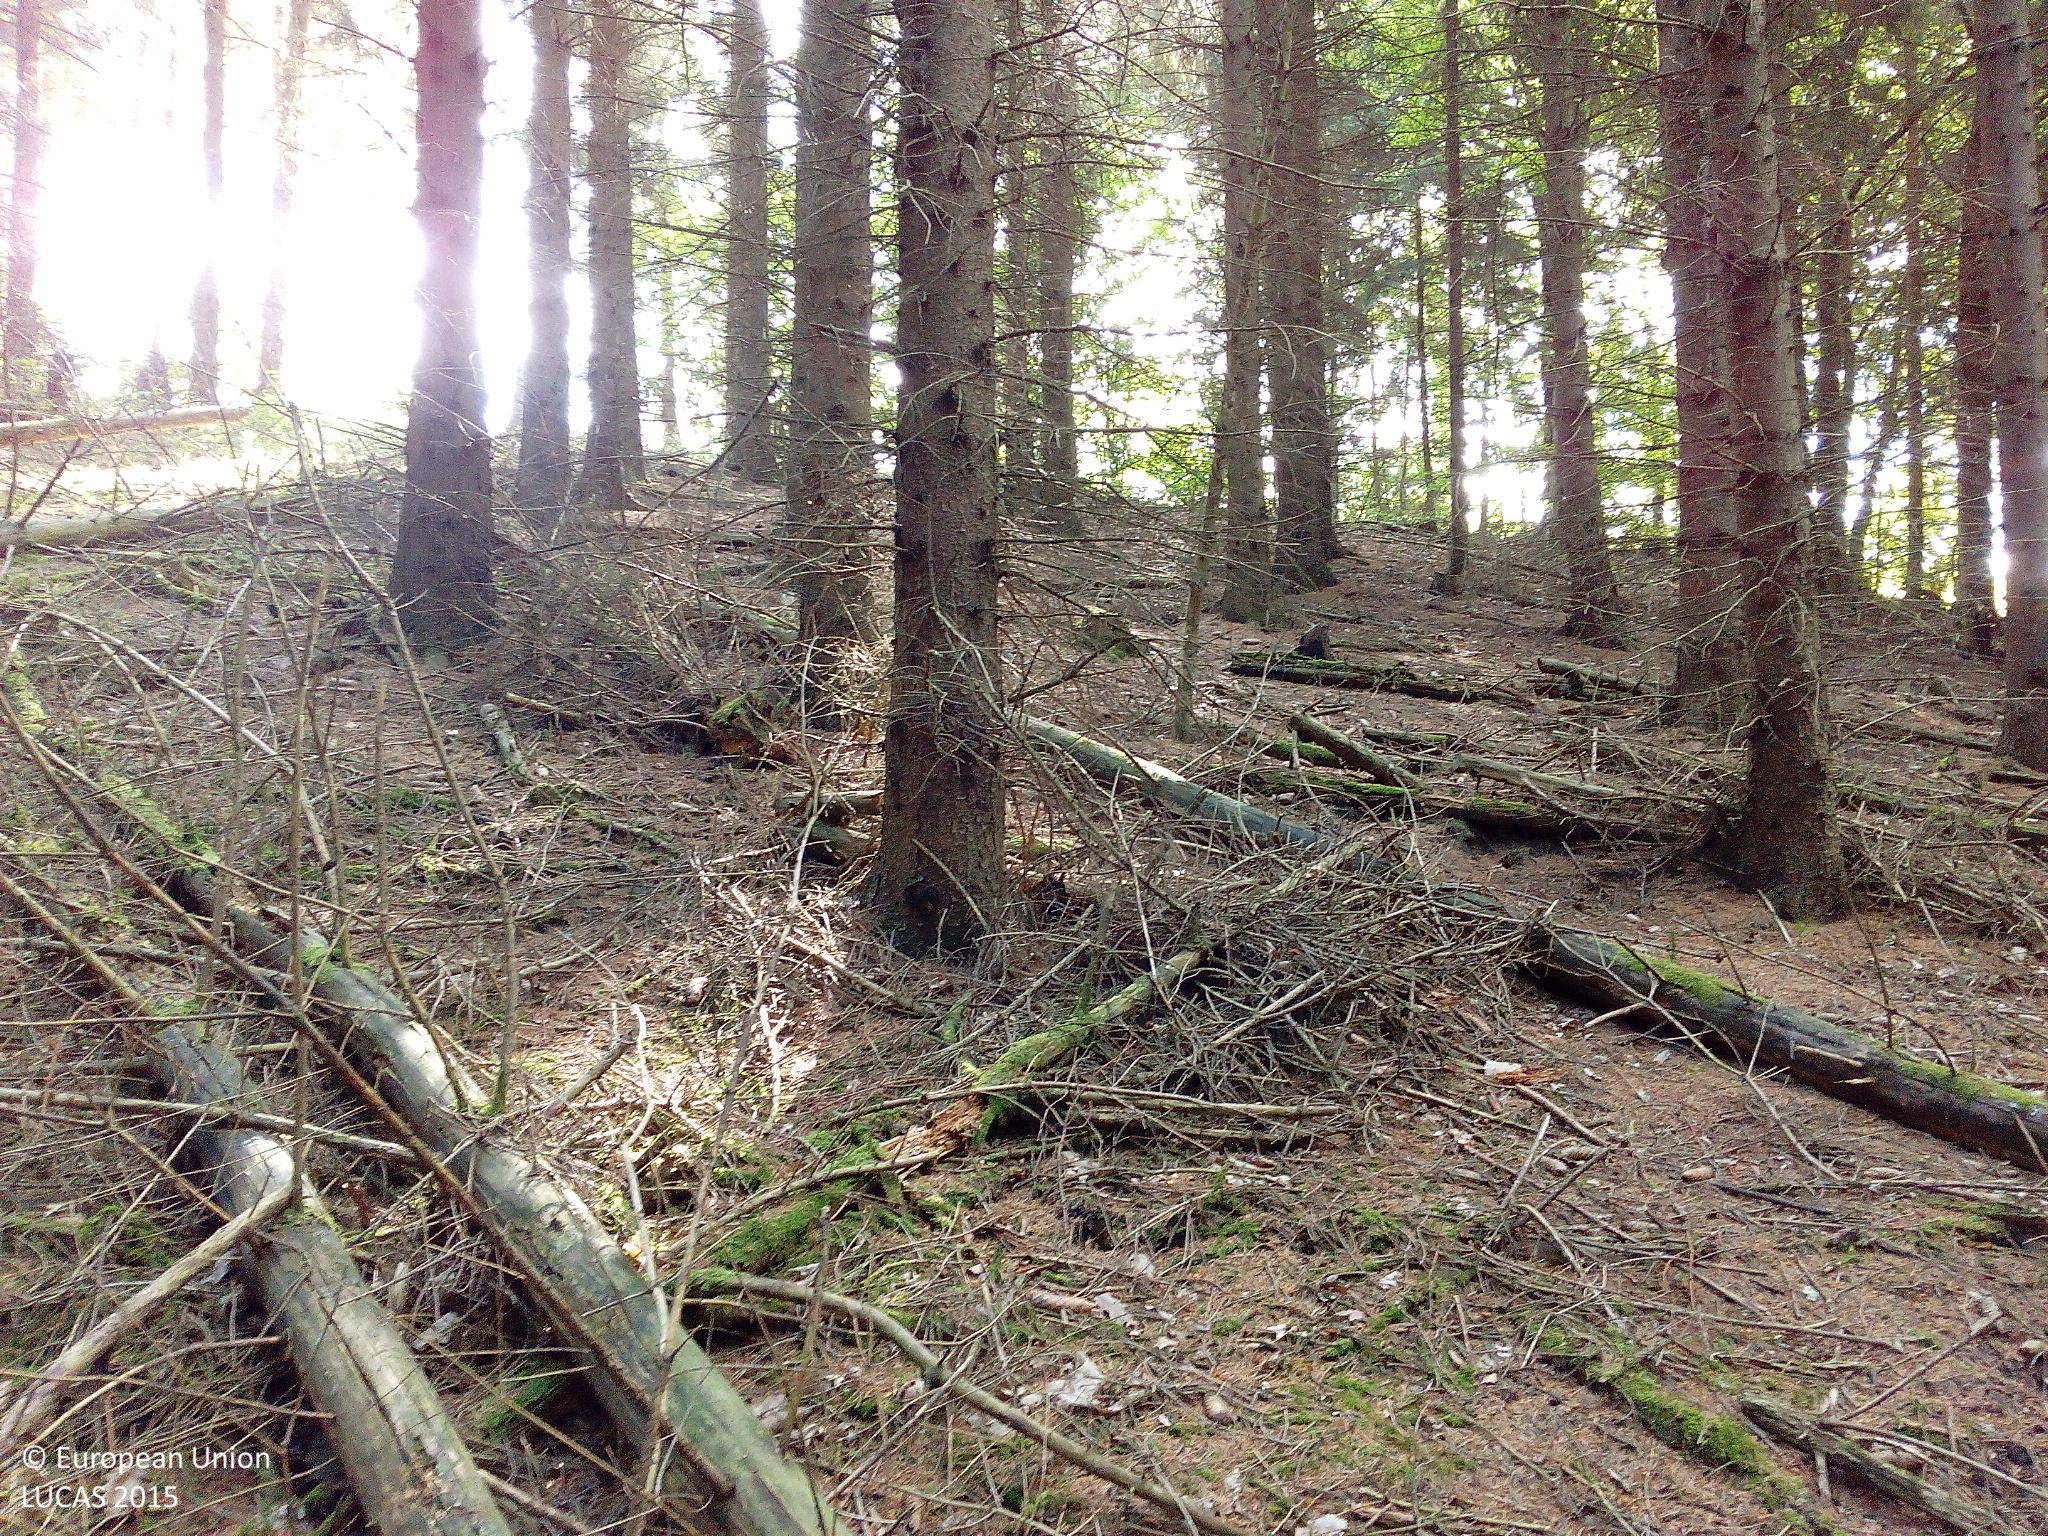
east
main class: Woodland
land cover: Spruce dominated coniferous woodland
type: hemiboreal forest and nemoral coniferous forest and mixed broadleaved-coniferous forest
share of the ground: > 75 %
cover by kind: coniferous forest trees 95 %, unconsolidated bare surface 5 %
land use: Forestry
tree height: > 5 m
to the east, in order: Spruce dominated coniferous woodland; Grass margins; Tracks; Grass margins; Ditches and canals; Grass margins; Common wheat; Grassland without tree/shrub cover; Paved roads, cycling and walking lanes; Grass margins; Maize
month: July
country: DE
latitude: 51.0832
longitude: 9.9572
